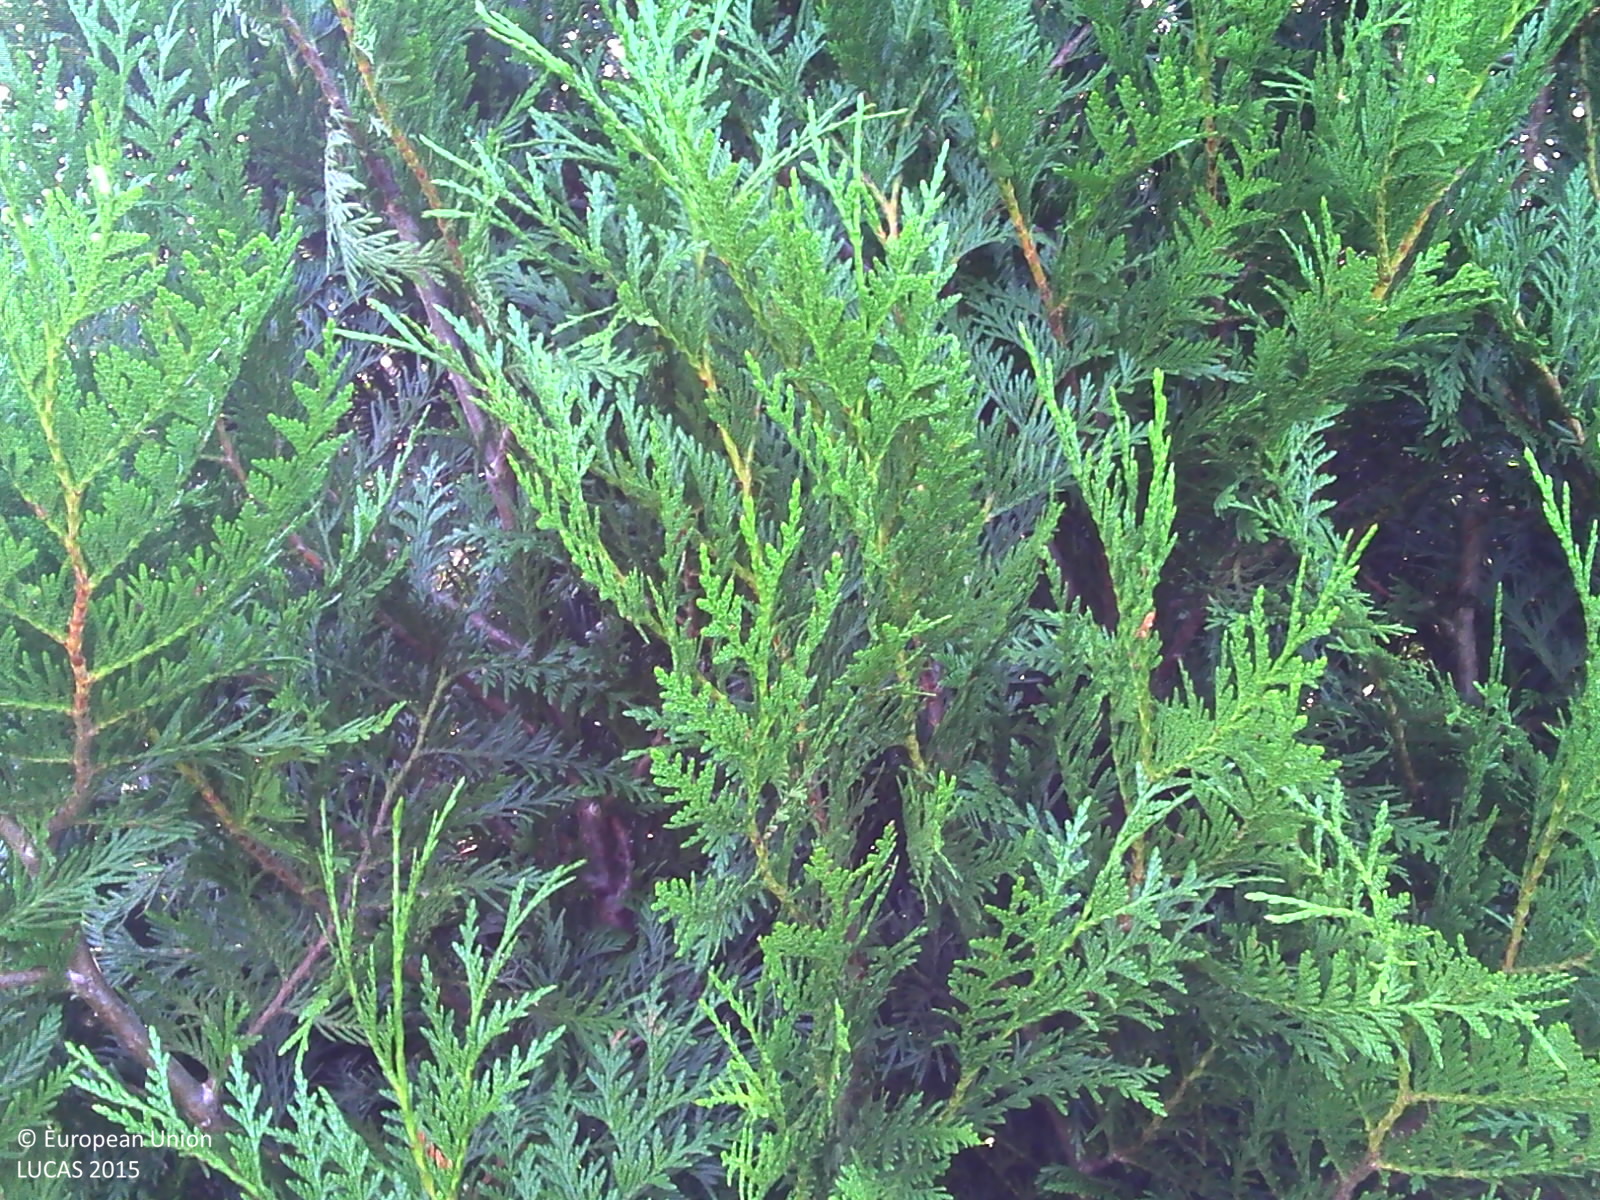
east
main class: Grassland
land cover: Grassland with sparse tree/shrub cover
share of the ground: > 75 %
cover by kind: herbaceous plants 95 %, broadleaved forest trees 5 %
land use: Residential
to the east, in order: Grassland with sparse tree/shrub cover; Conifer hedges; Electric lines; Paved roads, cycling and walking lanes; Other bare soil; Artificial constructions in urban areas; Broadleaved woodland
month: July
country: BE
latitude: 50.3365
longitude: 4.8124
